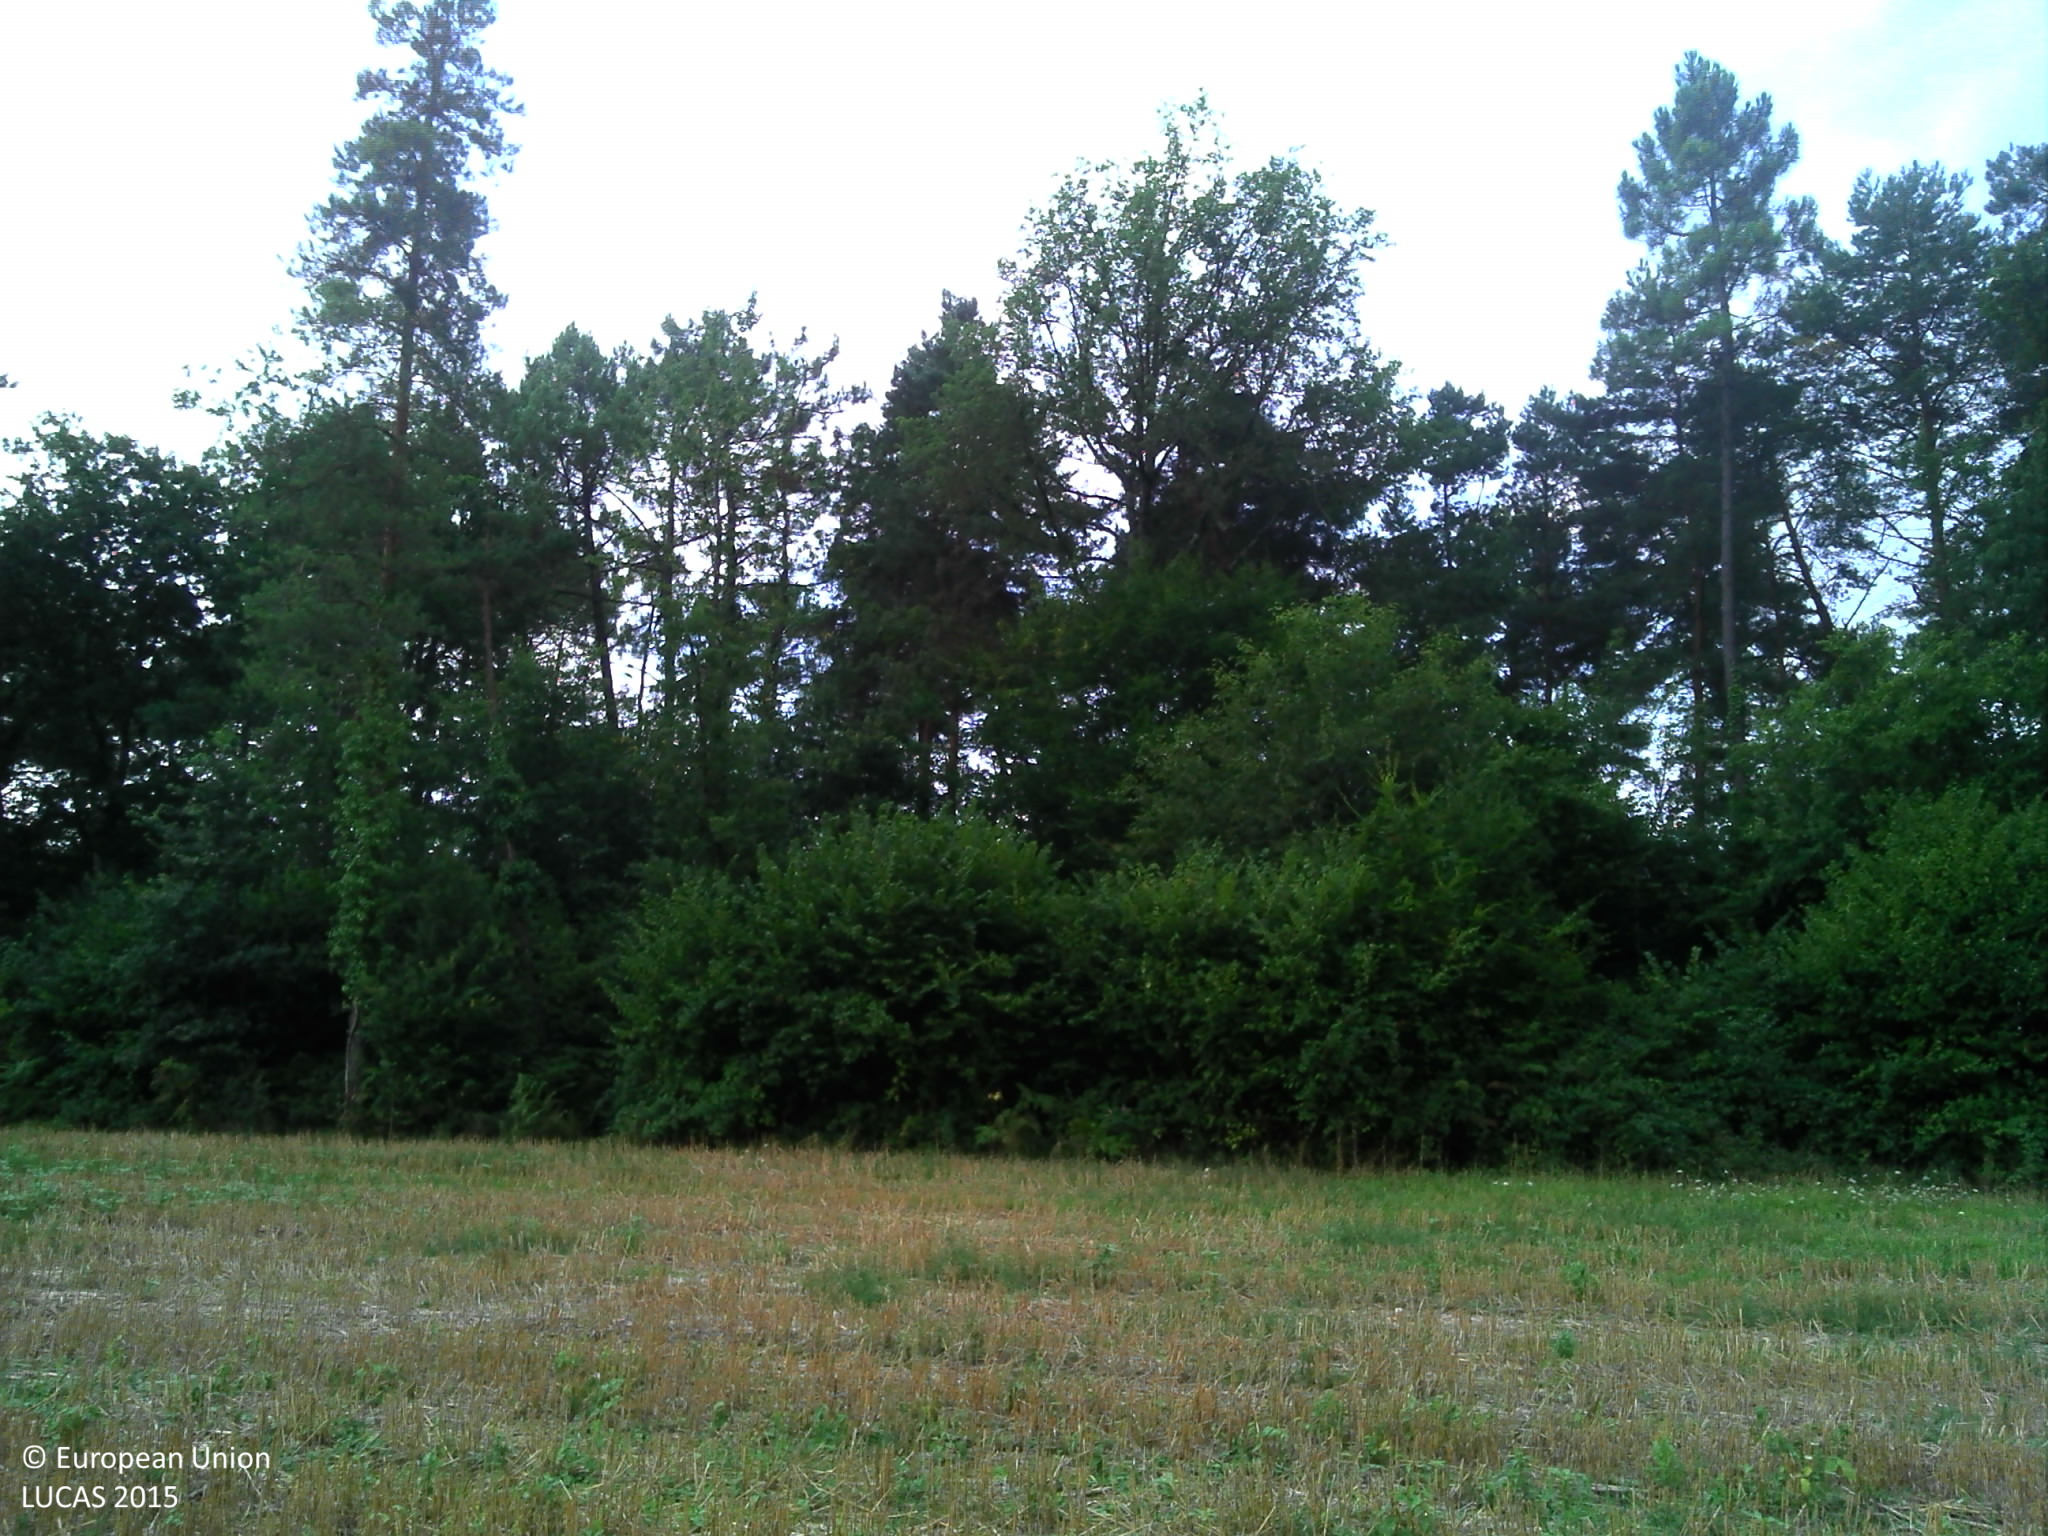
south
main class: Cropland
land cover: Temporary grasslands
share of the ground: > 75 %
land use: Agriculture (excluding fallow land and kitchen gardens)
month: August
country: FR
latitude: 45.3881
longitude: 0.7550
